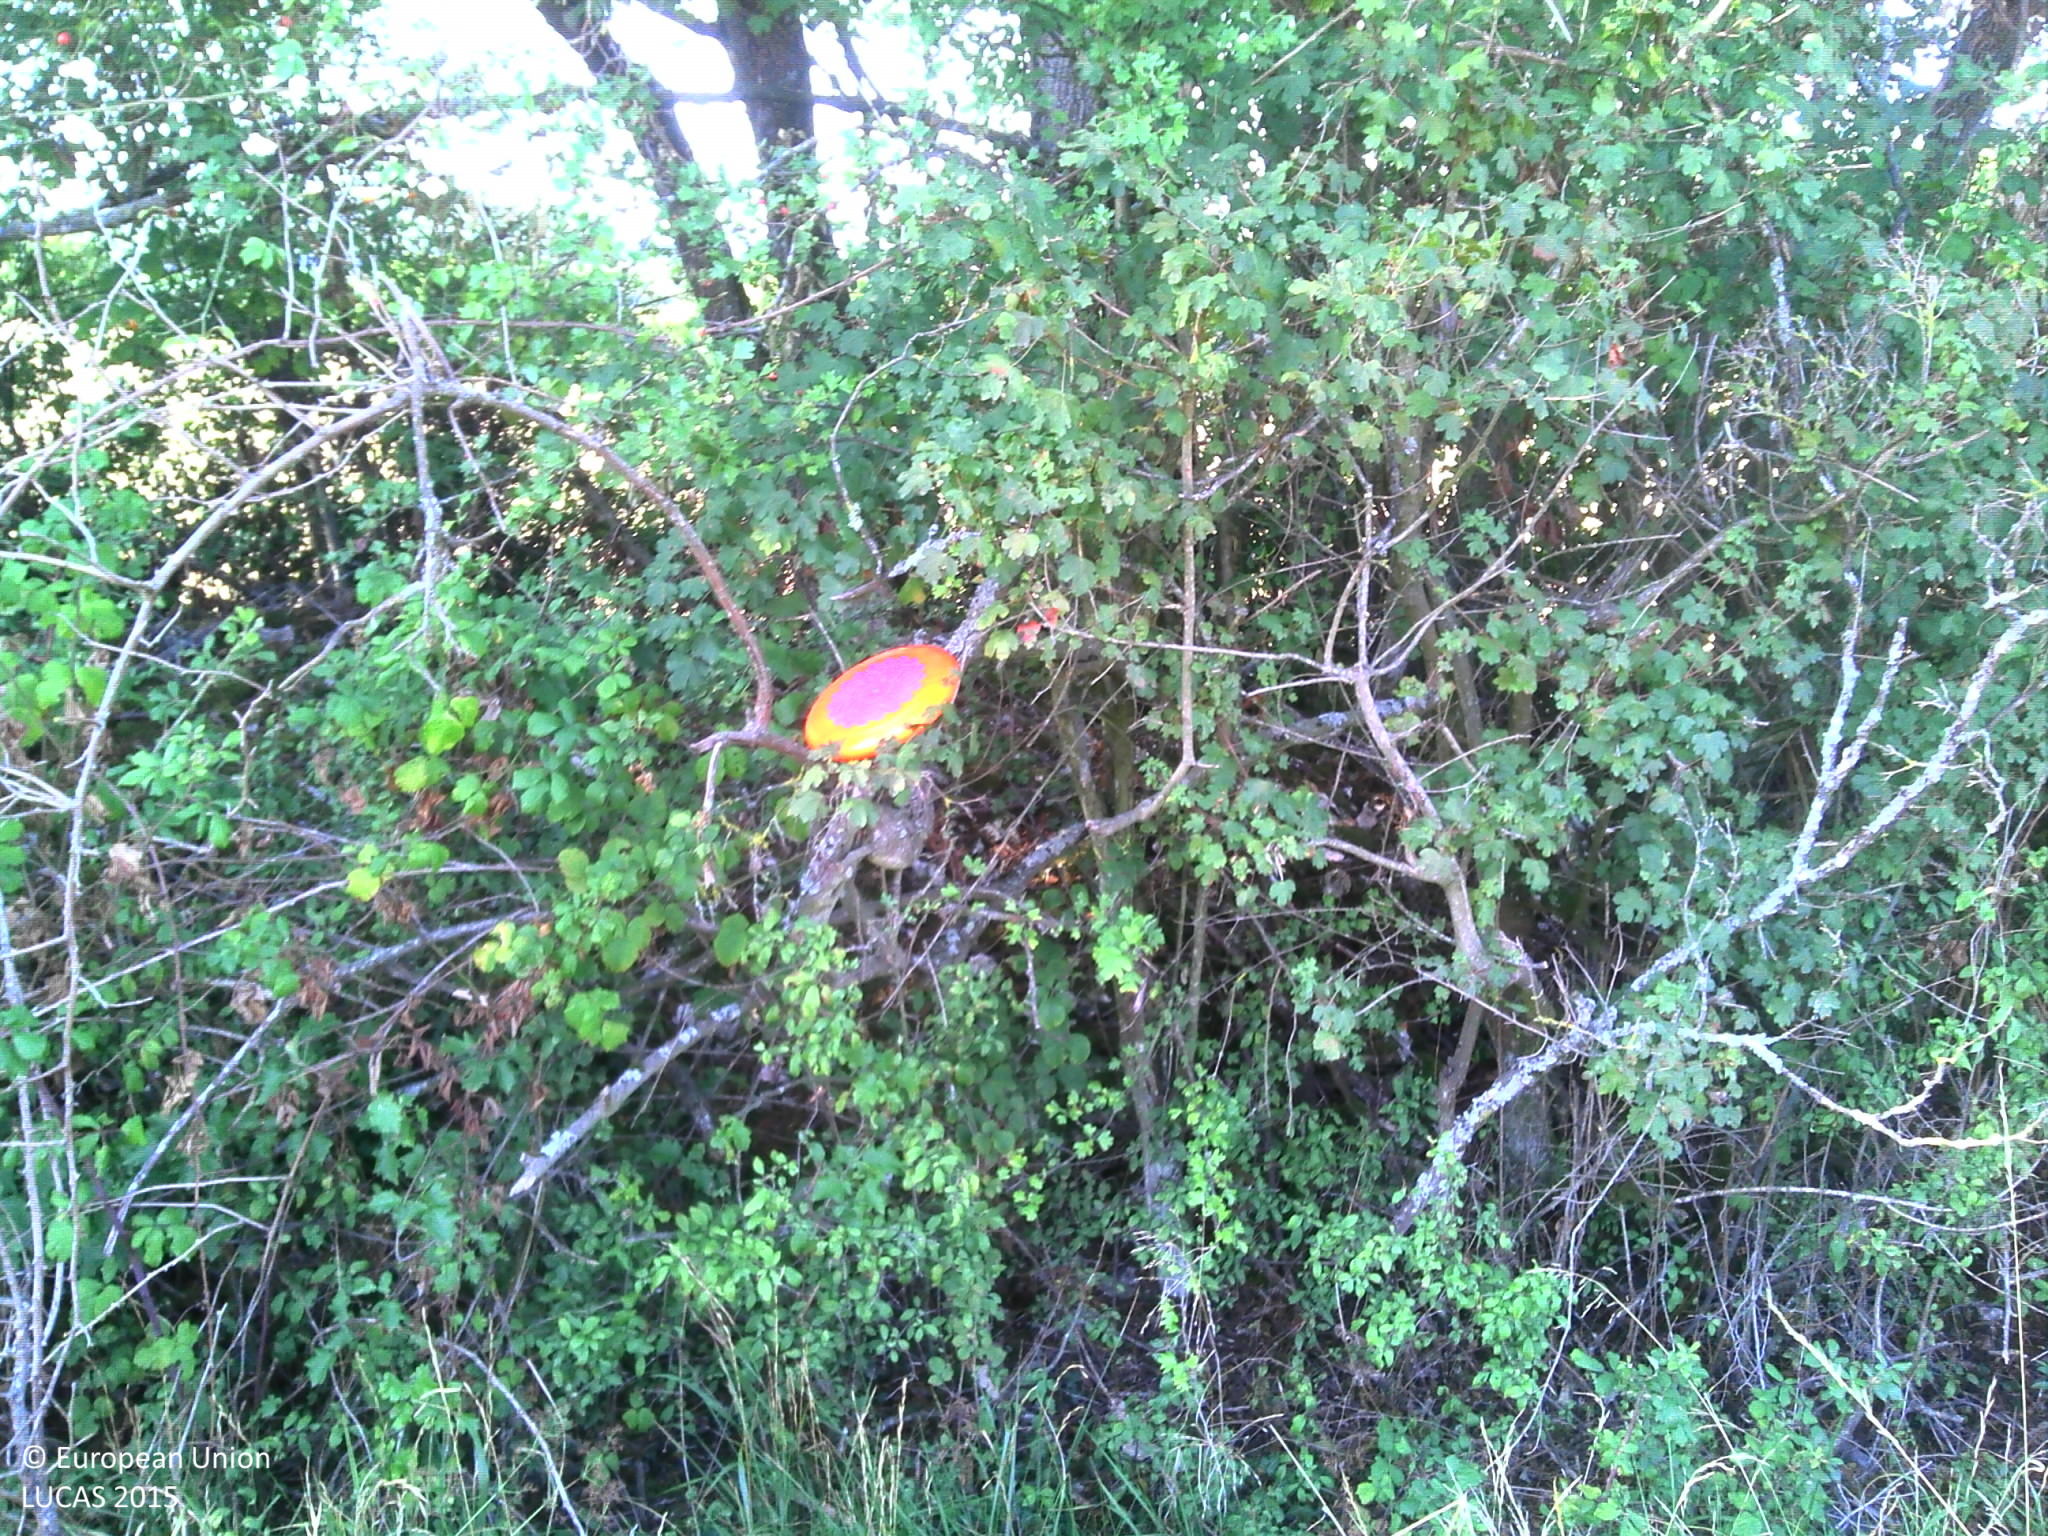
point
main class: Woodland
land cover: Broadleaved woodland
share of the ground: > 75 %
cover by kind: broadleaved forest trees 100 %
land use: Agriculture (excluding fallow land and kitchen gardens)
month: August
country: FR
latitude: 46.4584
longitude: 4.7807
